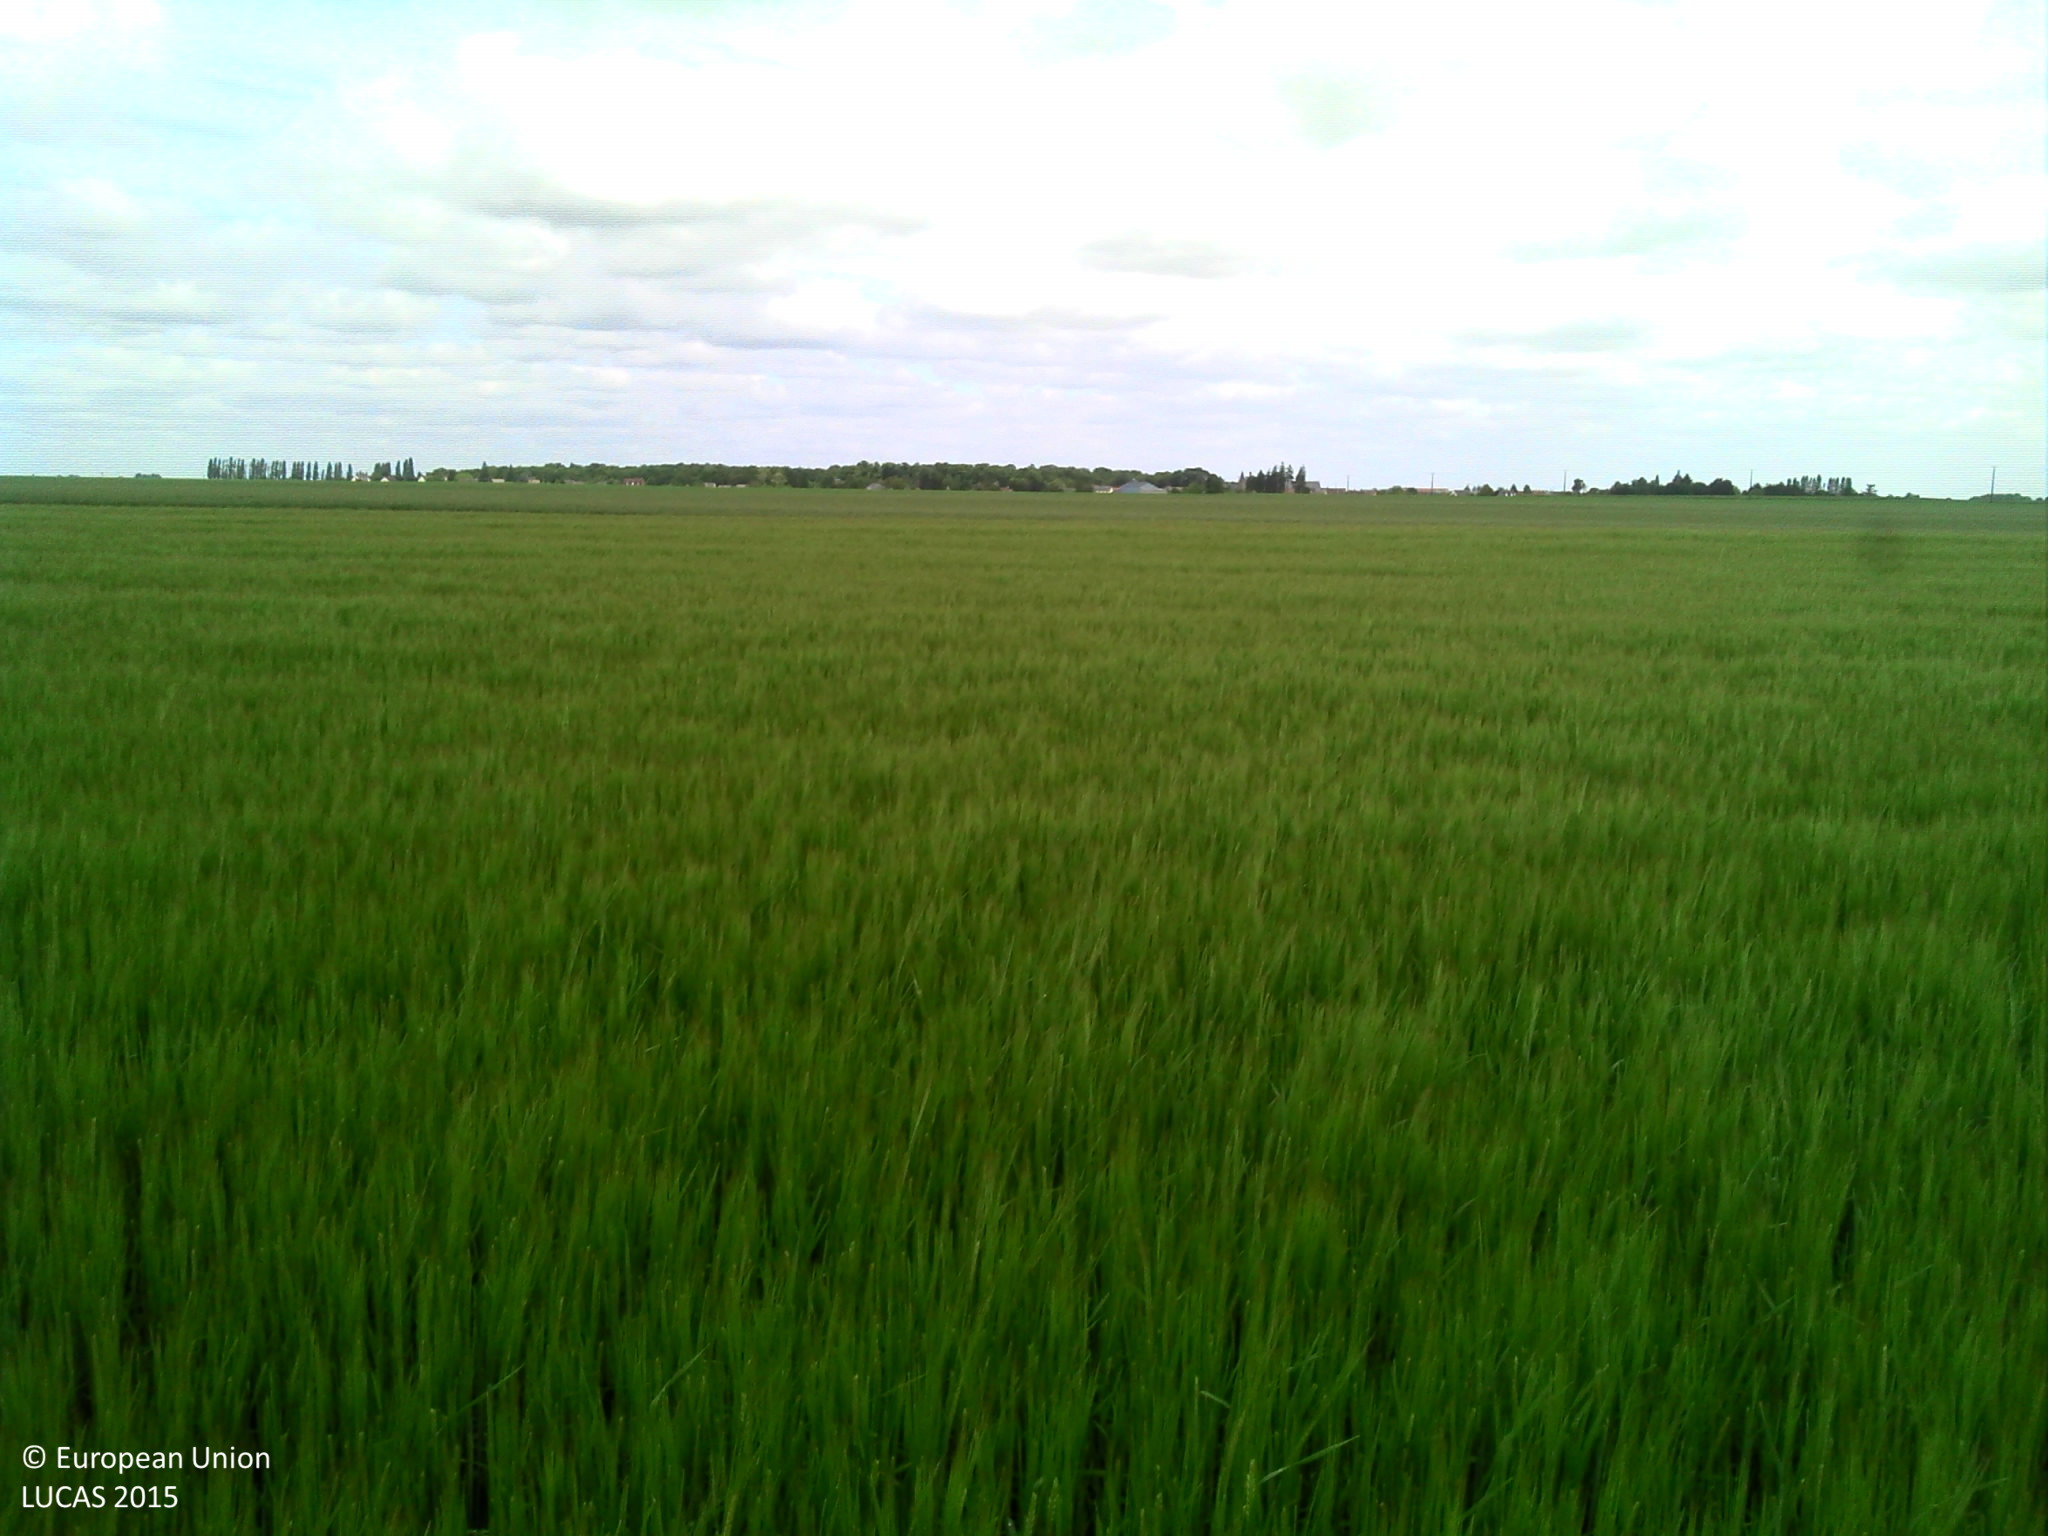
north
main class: Cropland
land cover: Barley
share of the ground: > 75 %
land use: Agriculture (excluding fallow land and kitchen gardens)
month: June
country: FR
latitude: 48.3811
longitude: 1.9527
